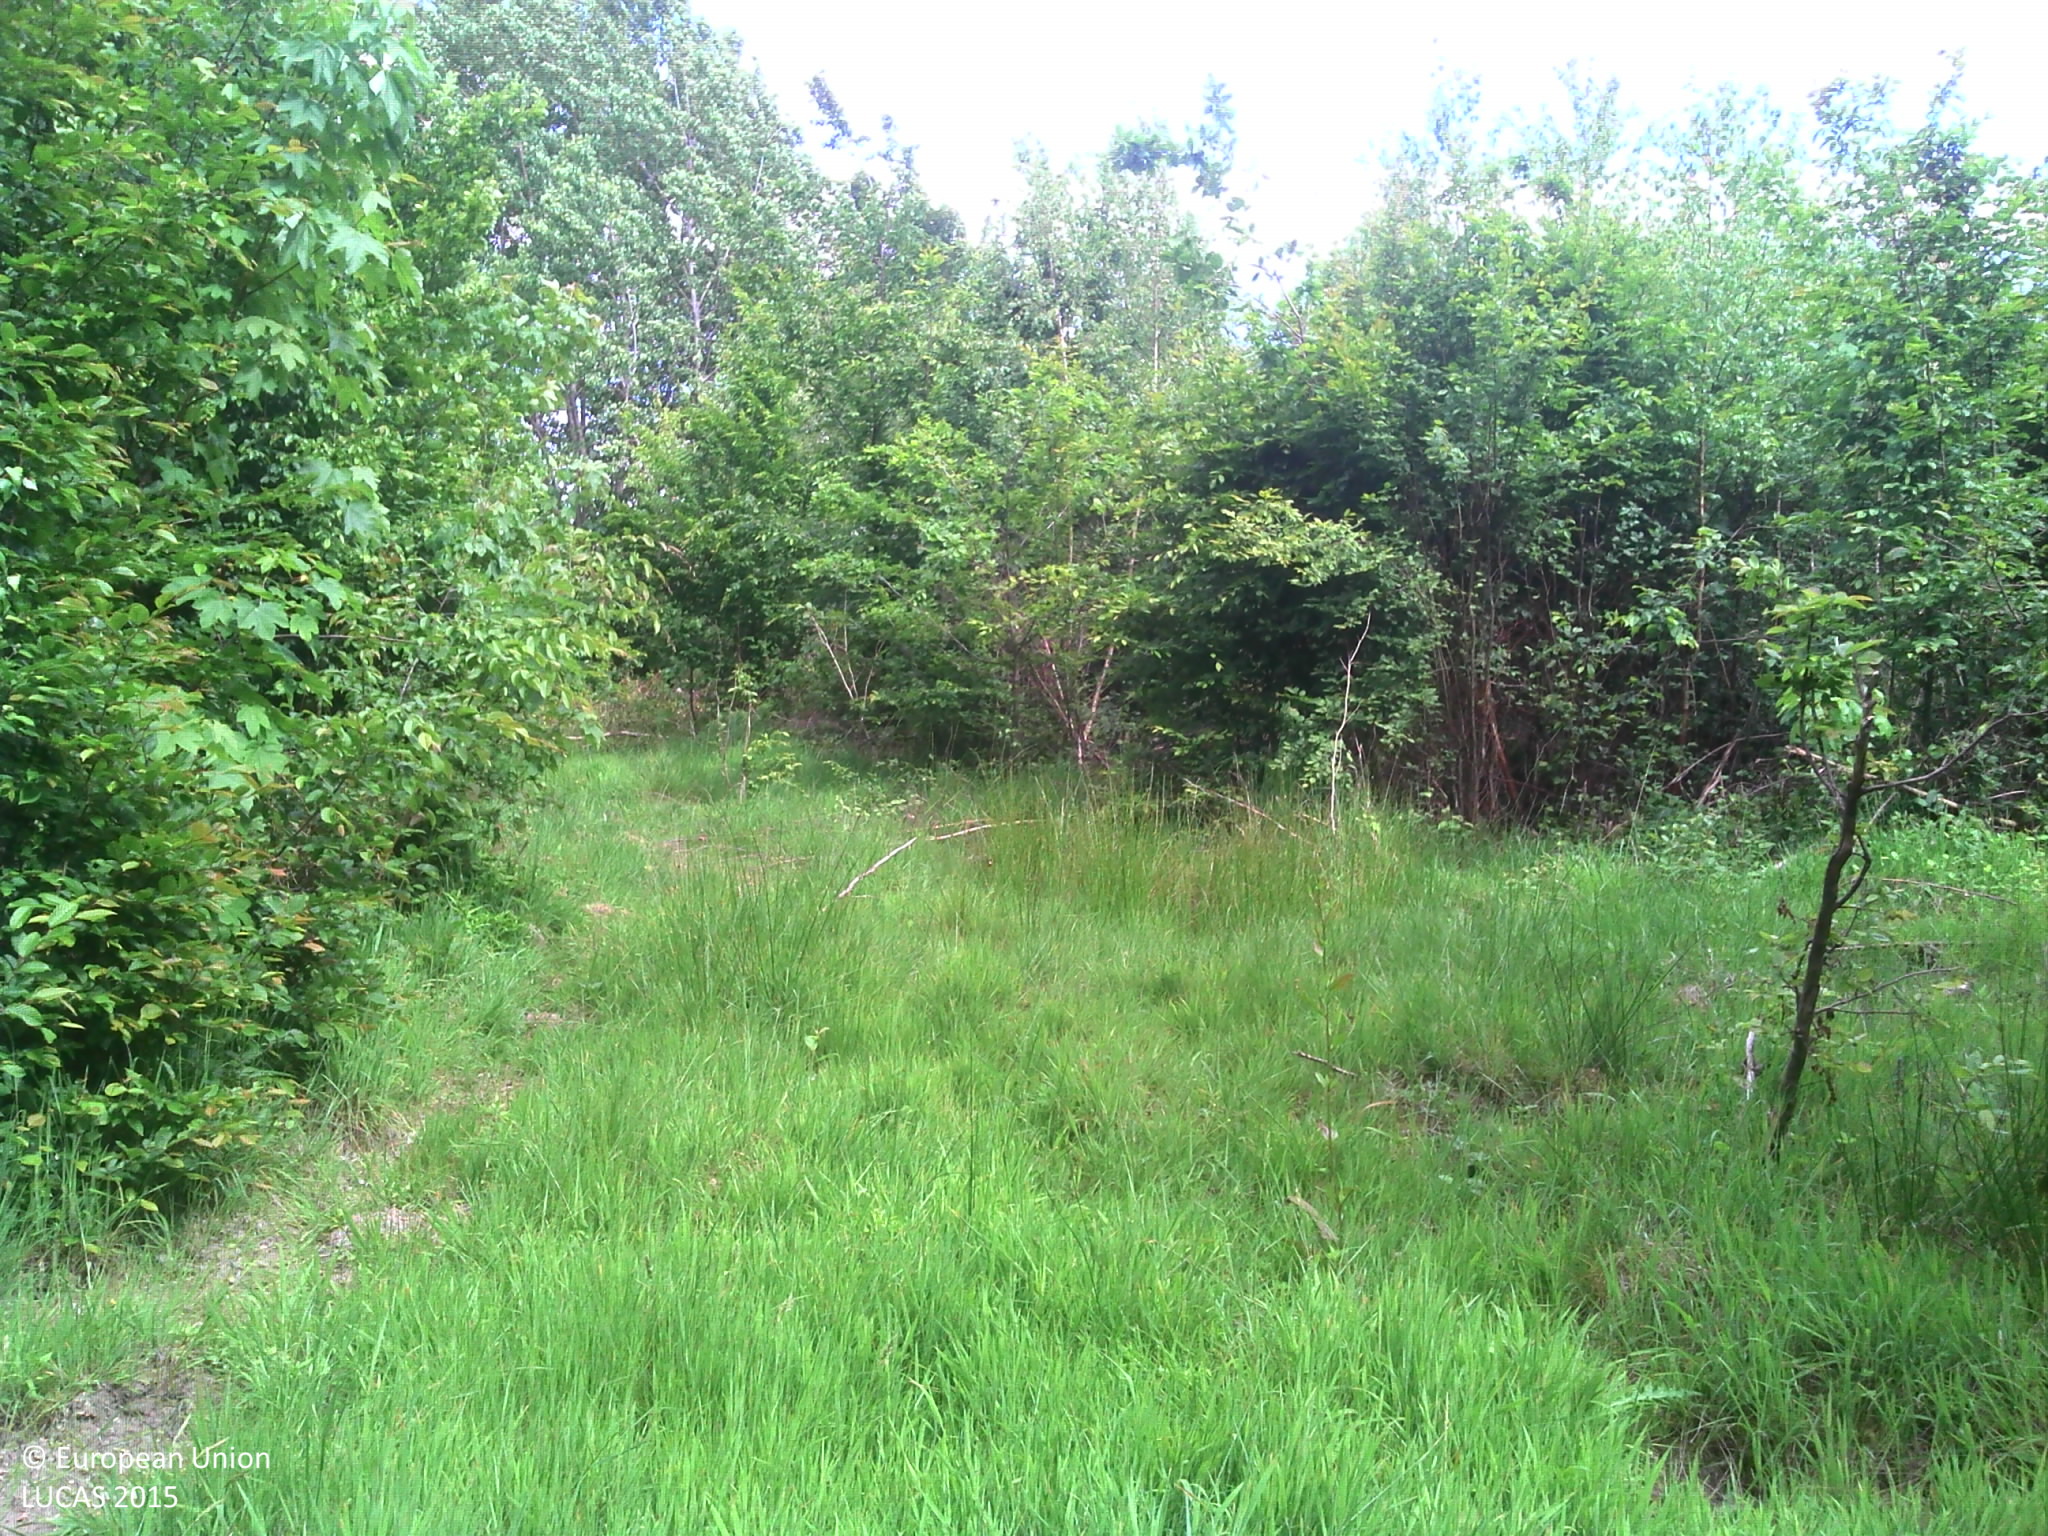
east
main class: Grassland
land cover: Grassland with sparse tree/shrub cover
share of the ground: > 75 %
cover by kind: herbaceous plants 95 %, broadleaved forest trees 5 %
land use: Semi-natural and natural areas not in use
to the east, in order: Grassland with sparse tree/shrub cover; Broadleaved woodland
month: June
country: FR
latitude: 48.5762
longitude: 4.9425
